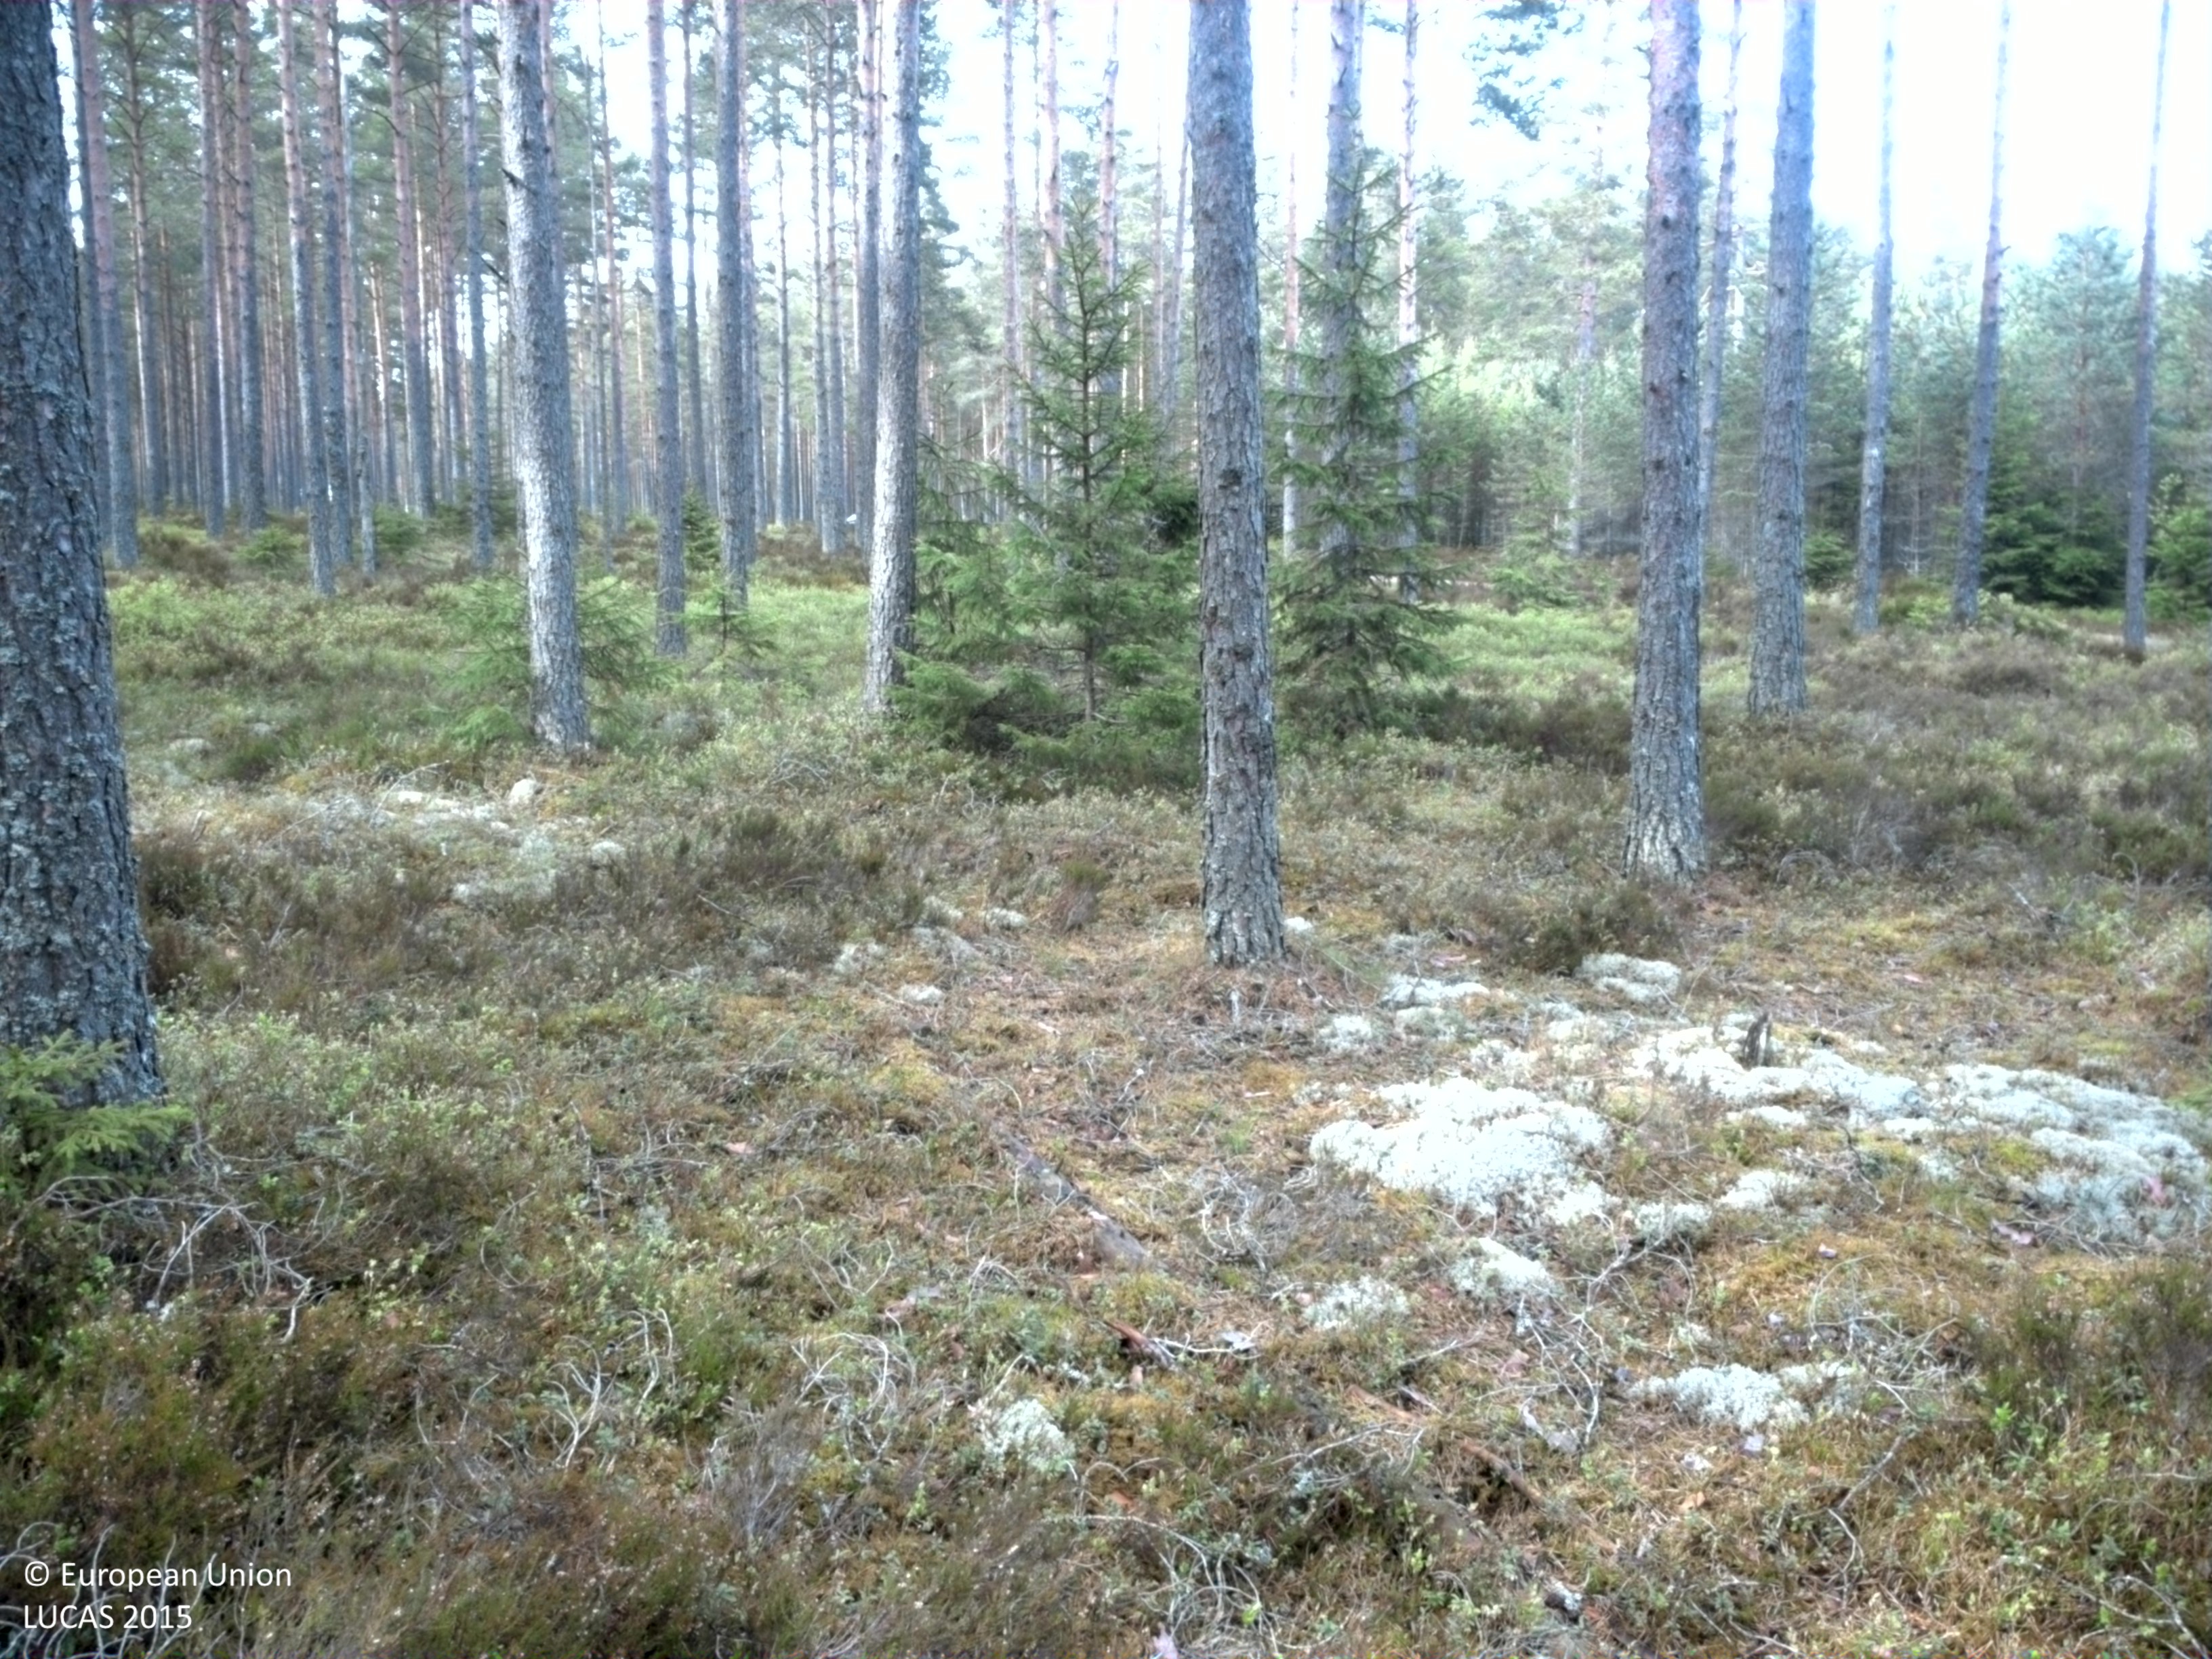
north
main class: Woodland
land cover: Pine dominated coniferous woodland
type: boreal forest
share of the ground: 50 - 75 %
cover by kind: coniferous forest trees 50 %, shrubs 40 %, herbaceous plants 5 %, lichens and mosses 5 %
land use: Forestry
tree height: > 5 m
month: May
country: SE
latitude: 59.1583
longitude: 14.3464
